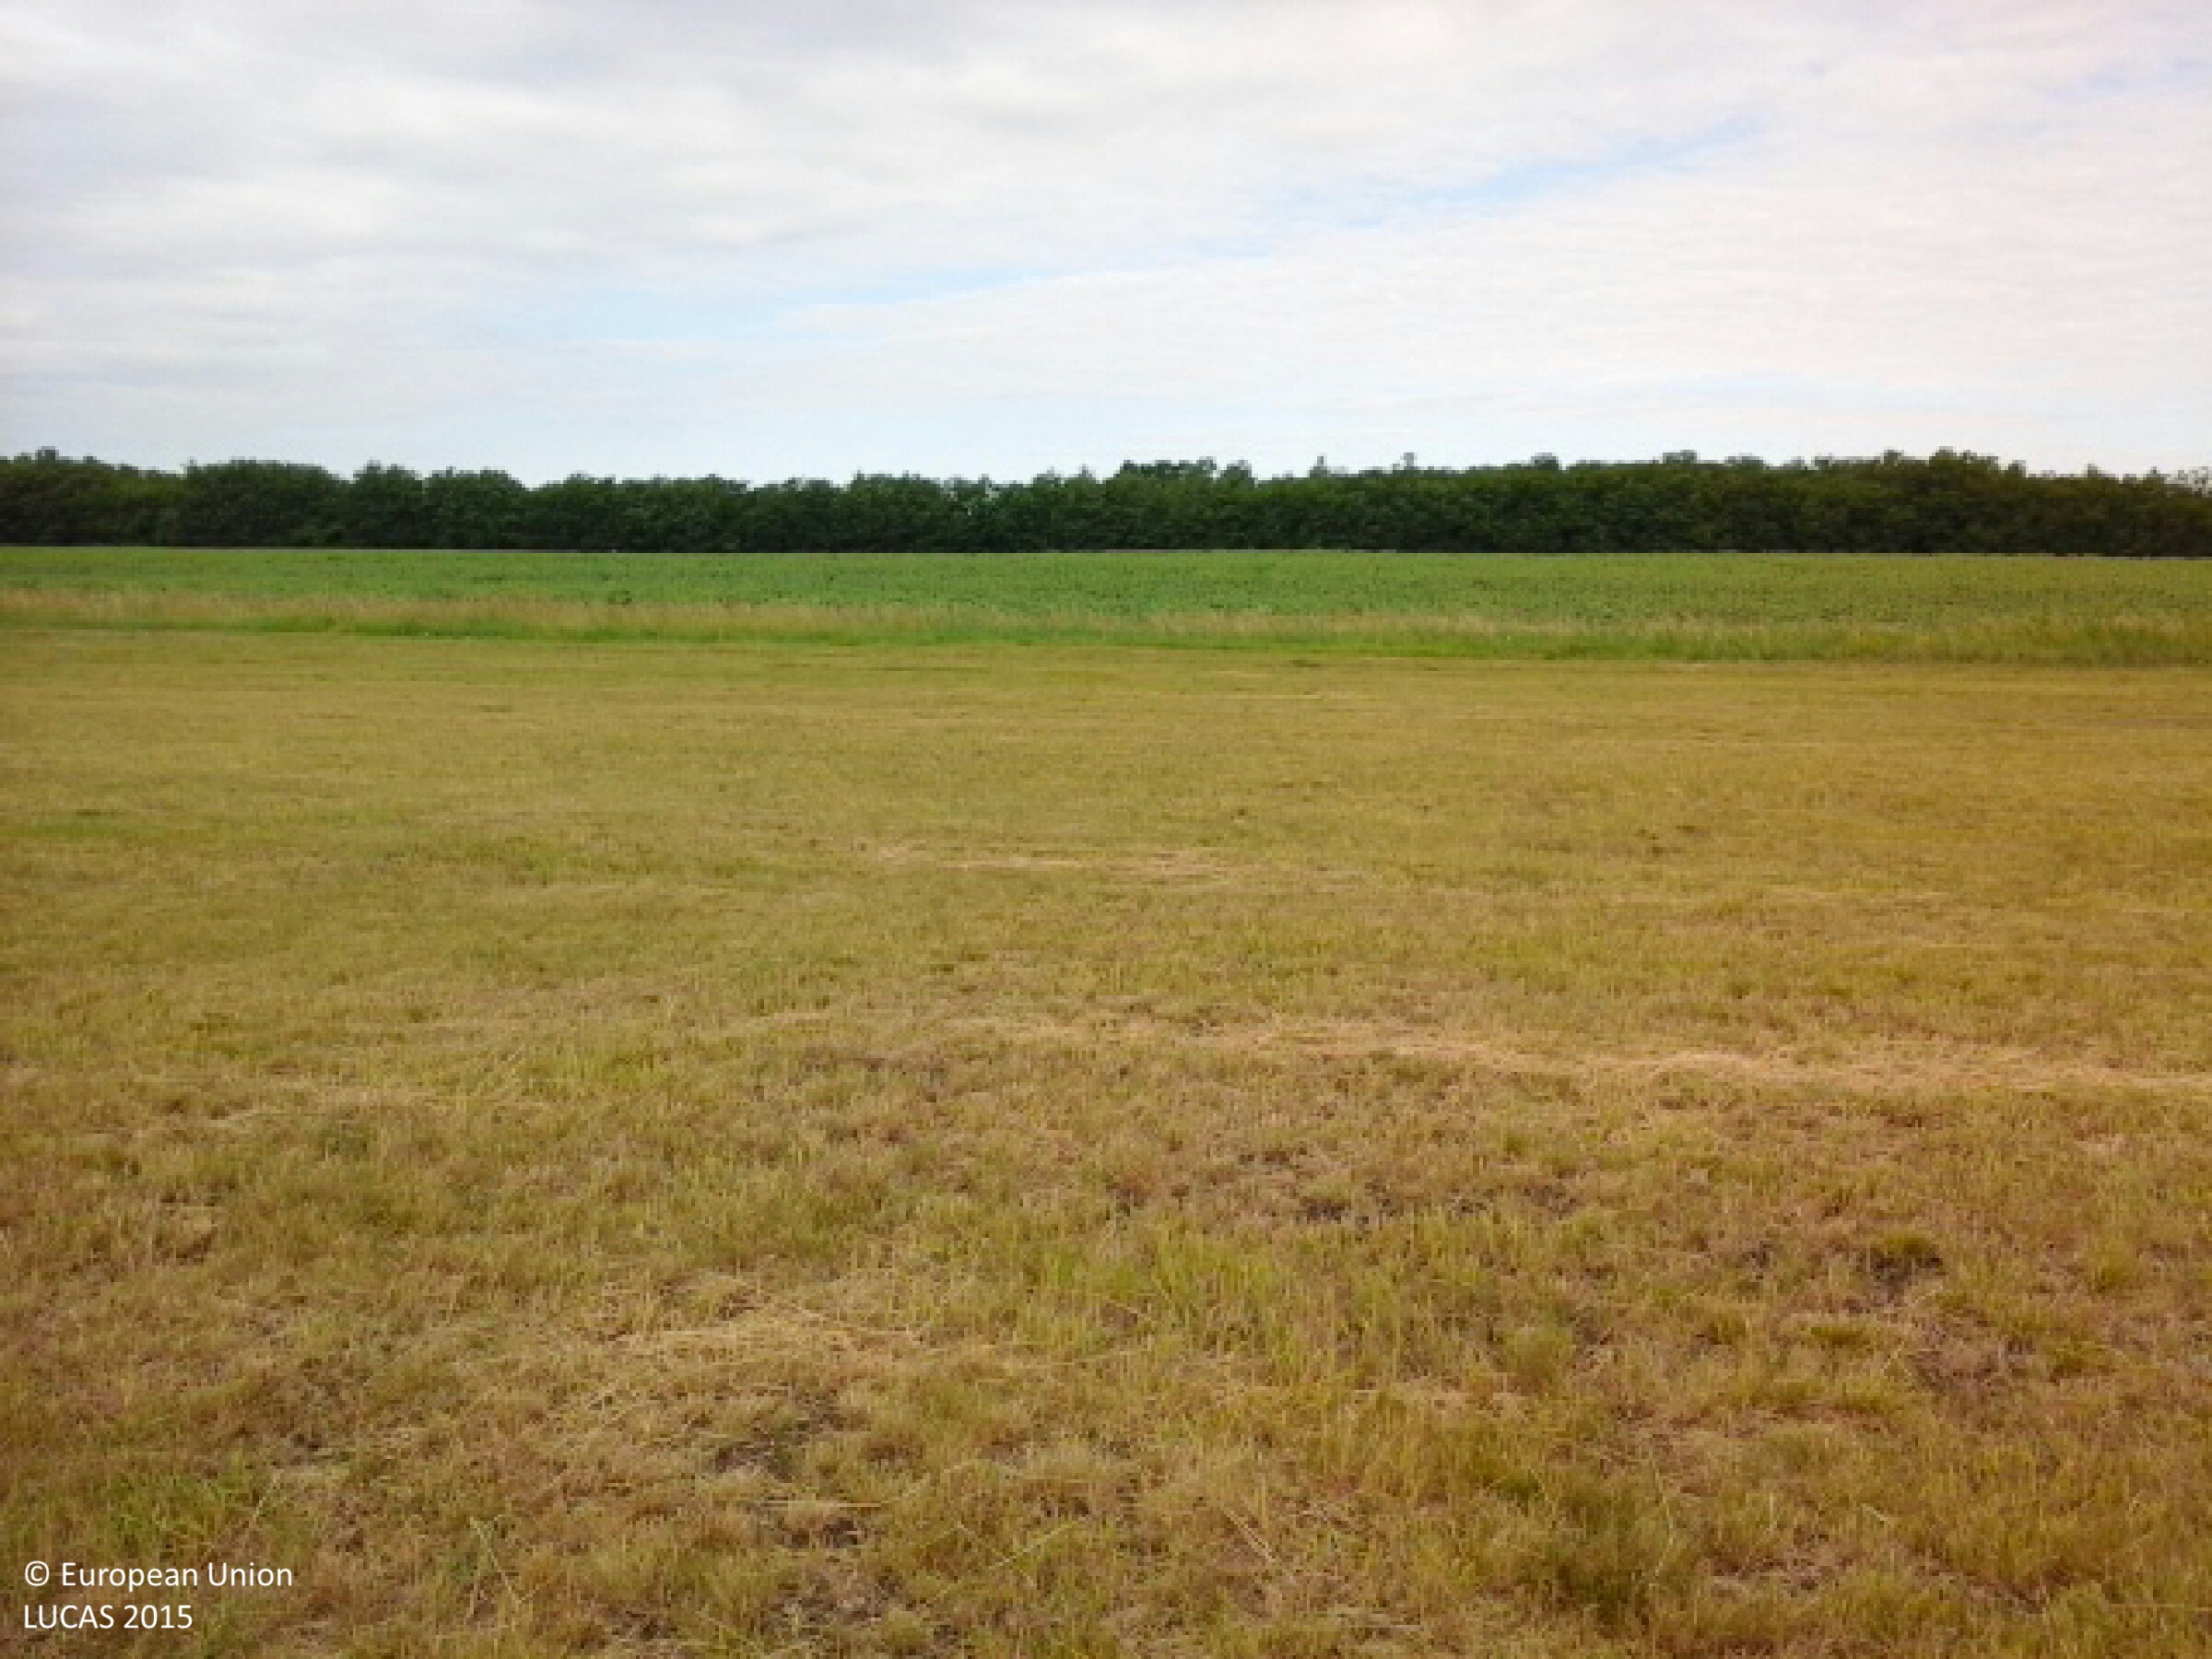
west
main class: Grassland
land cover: Grassland without tree/shrub cover
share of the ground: > 75 %
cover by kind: herbaceous plants 95 %, unconsolidated bare surface 5 %
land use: Agriculture (excluding fallow land and kitchen gardens)
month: June
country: HU
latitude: 48.0462
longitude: 21.7597
